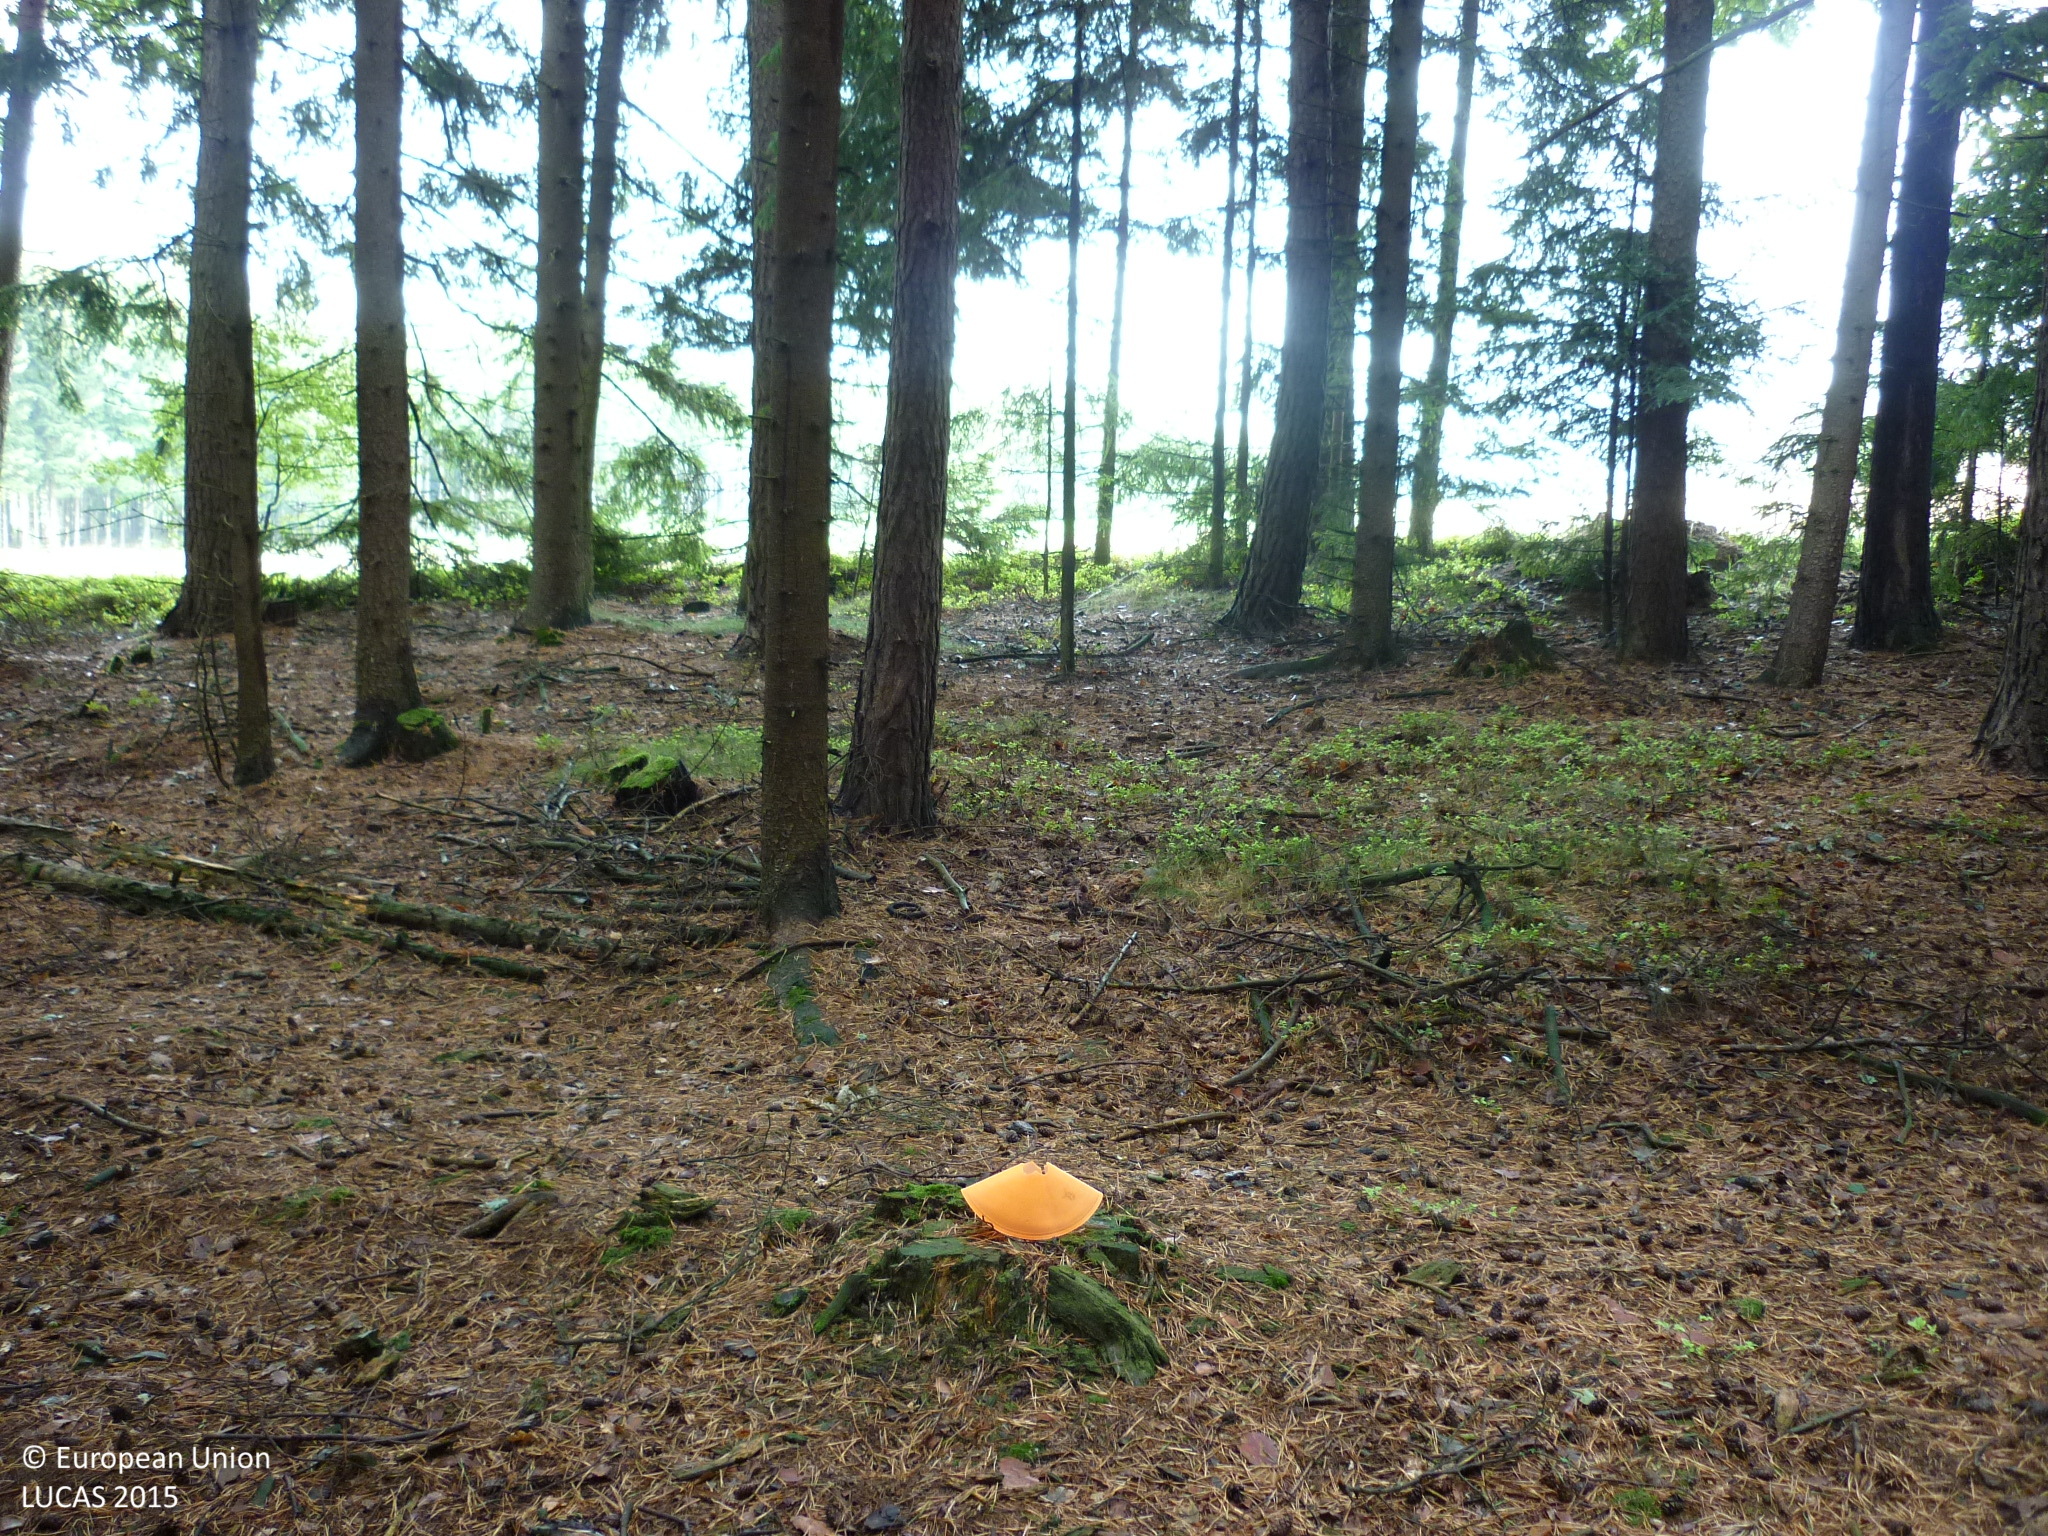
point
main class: Woodland
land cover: Spruce dominated coniferous woodland
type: hemiboreal forest and nemoral coniferous forest and mixed broadleaved-coniferous forest
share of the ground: > 75 %
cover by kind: coniferous forest trees 100 %
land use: Forestry
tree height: > 5 m
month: September
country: AT
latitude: 48.9543
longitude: 15.0687
